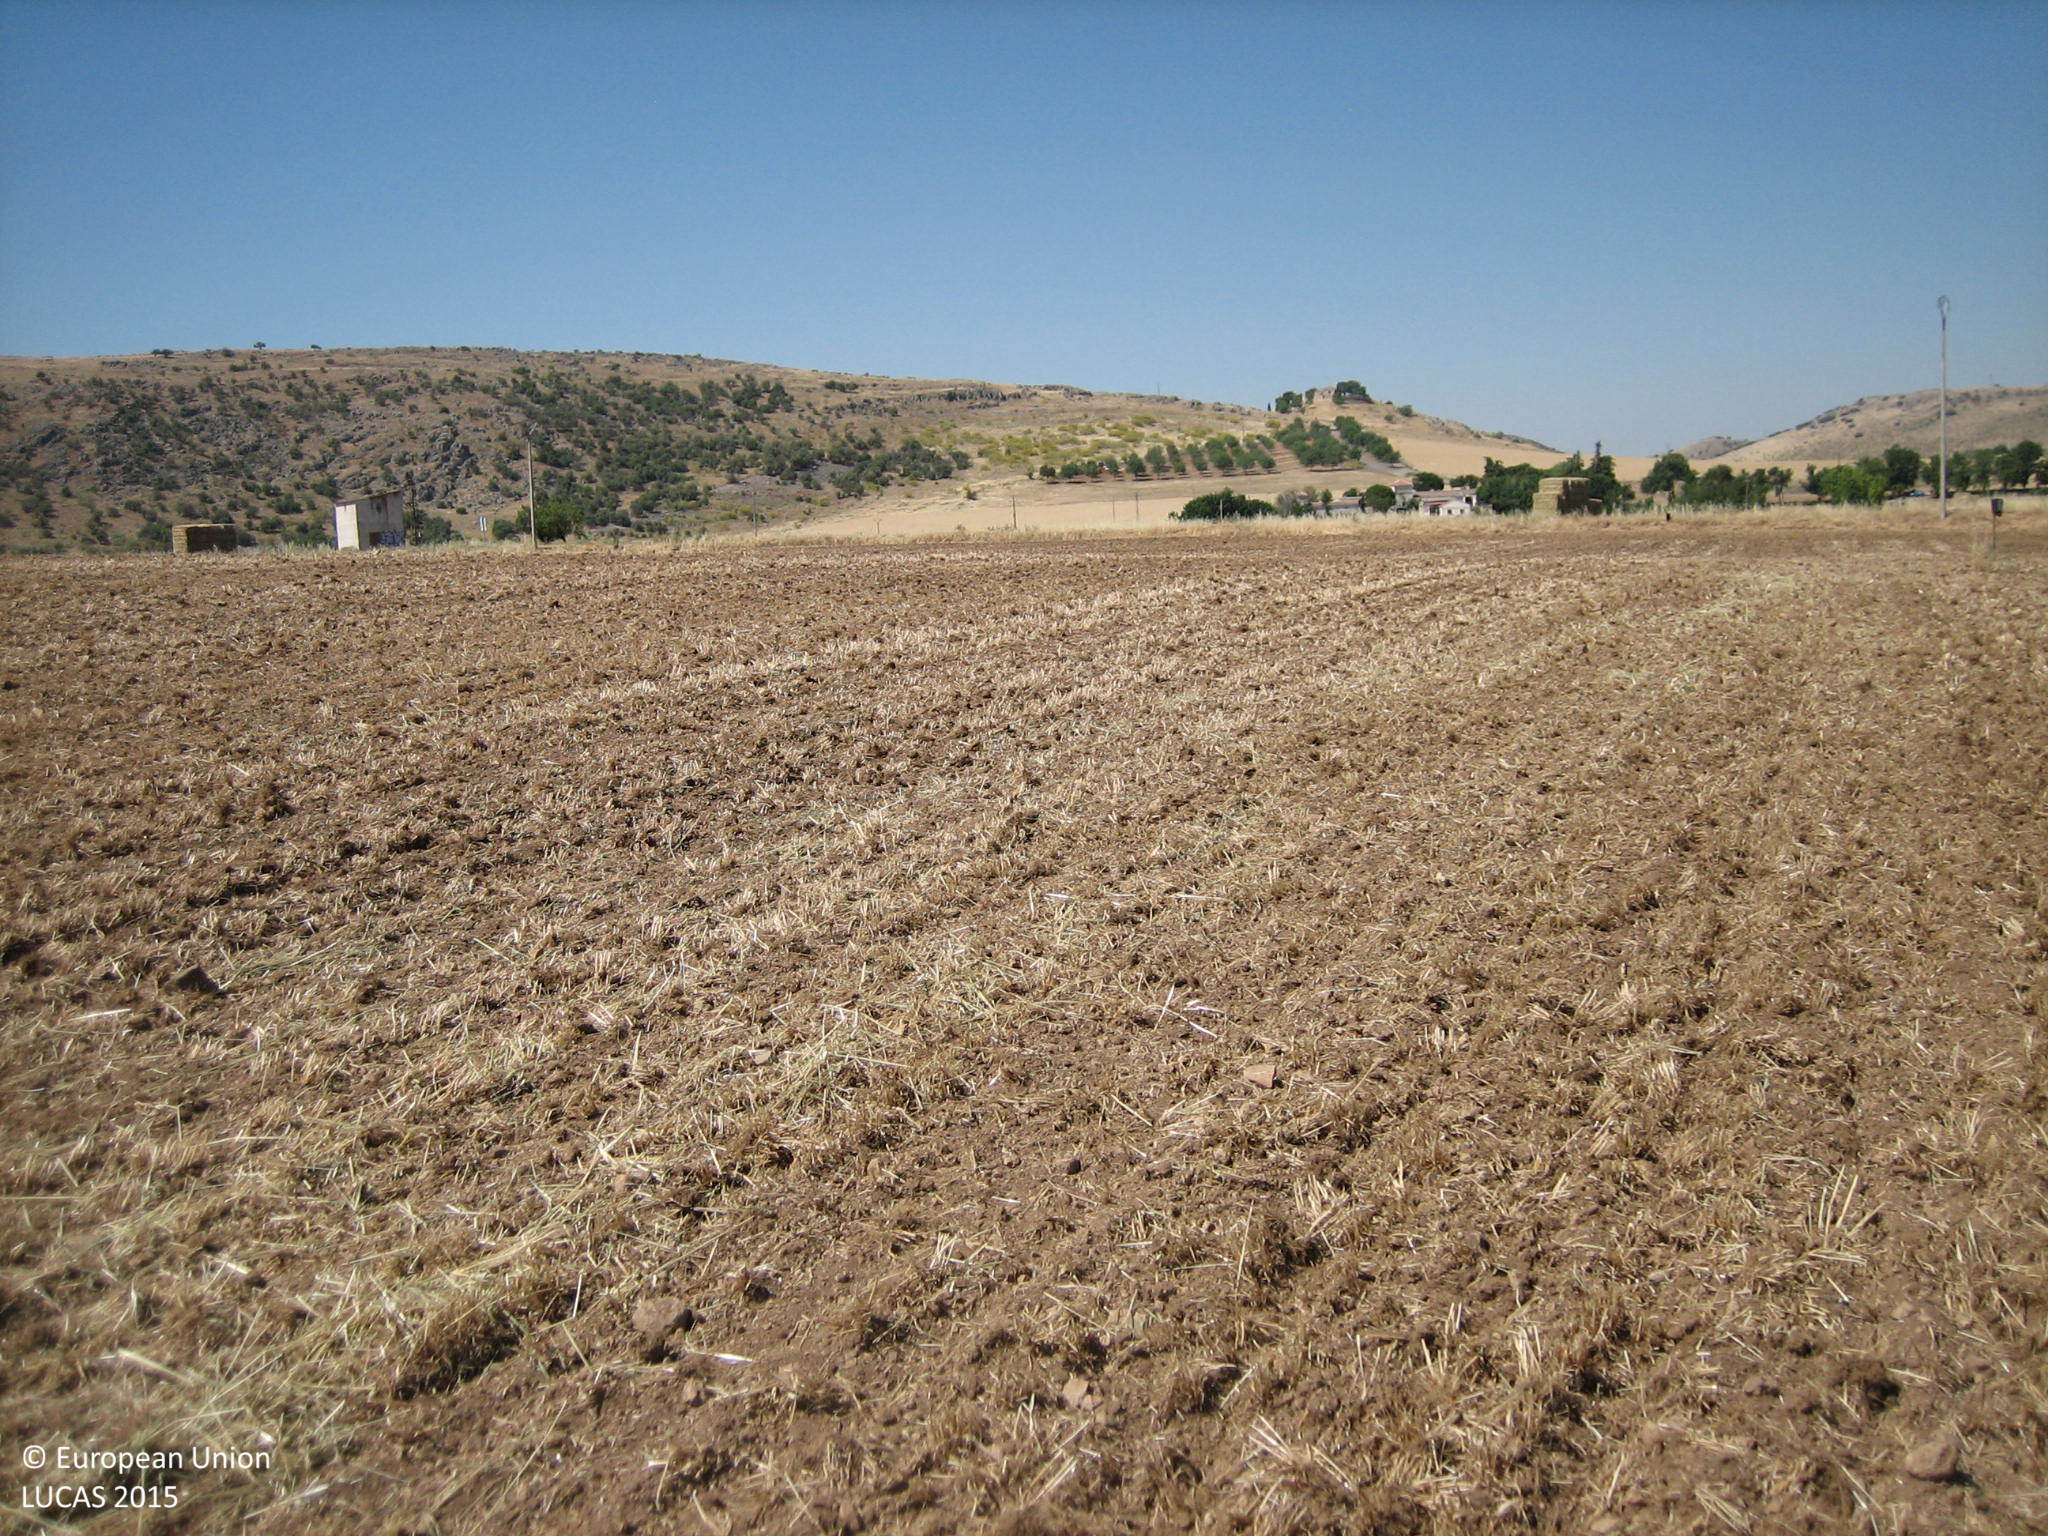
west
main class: Cropland
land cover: Oats
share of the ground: > 75 %
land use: Agriculture (excluding fallow land and kitchen gardens)
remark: Harvested field
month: May
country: ES
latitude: 38.9650
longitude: -3.9972
